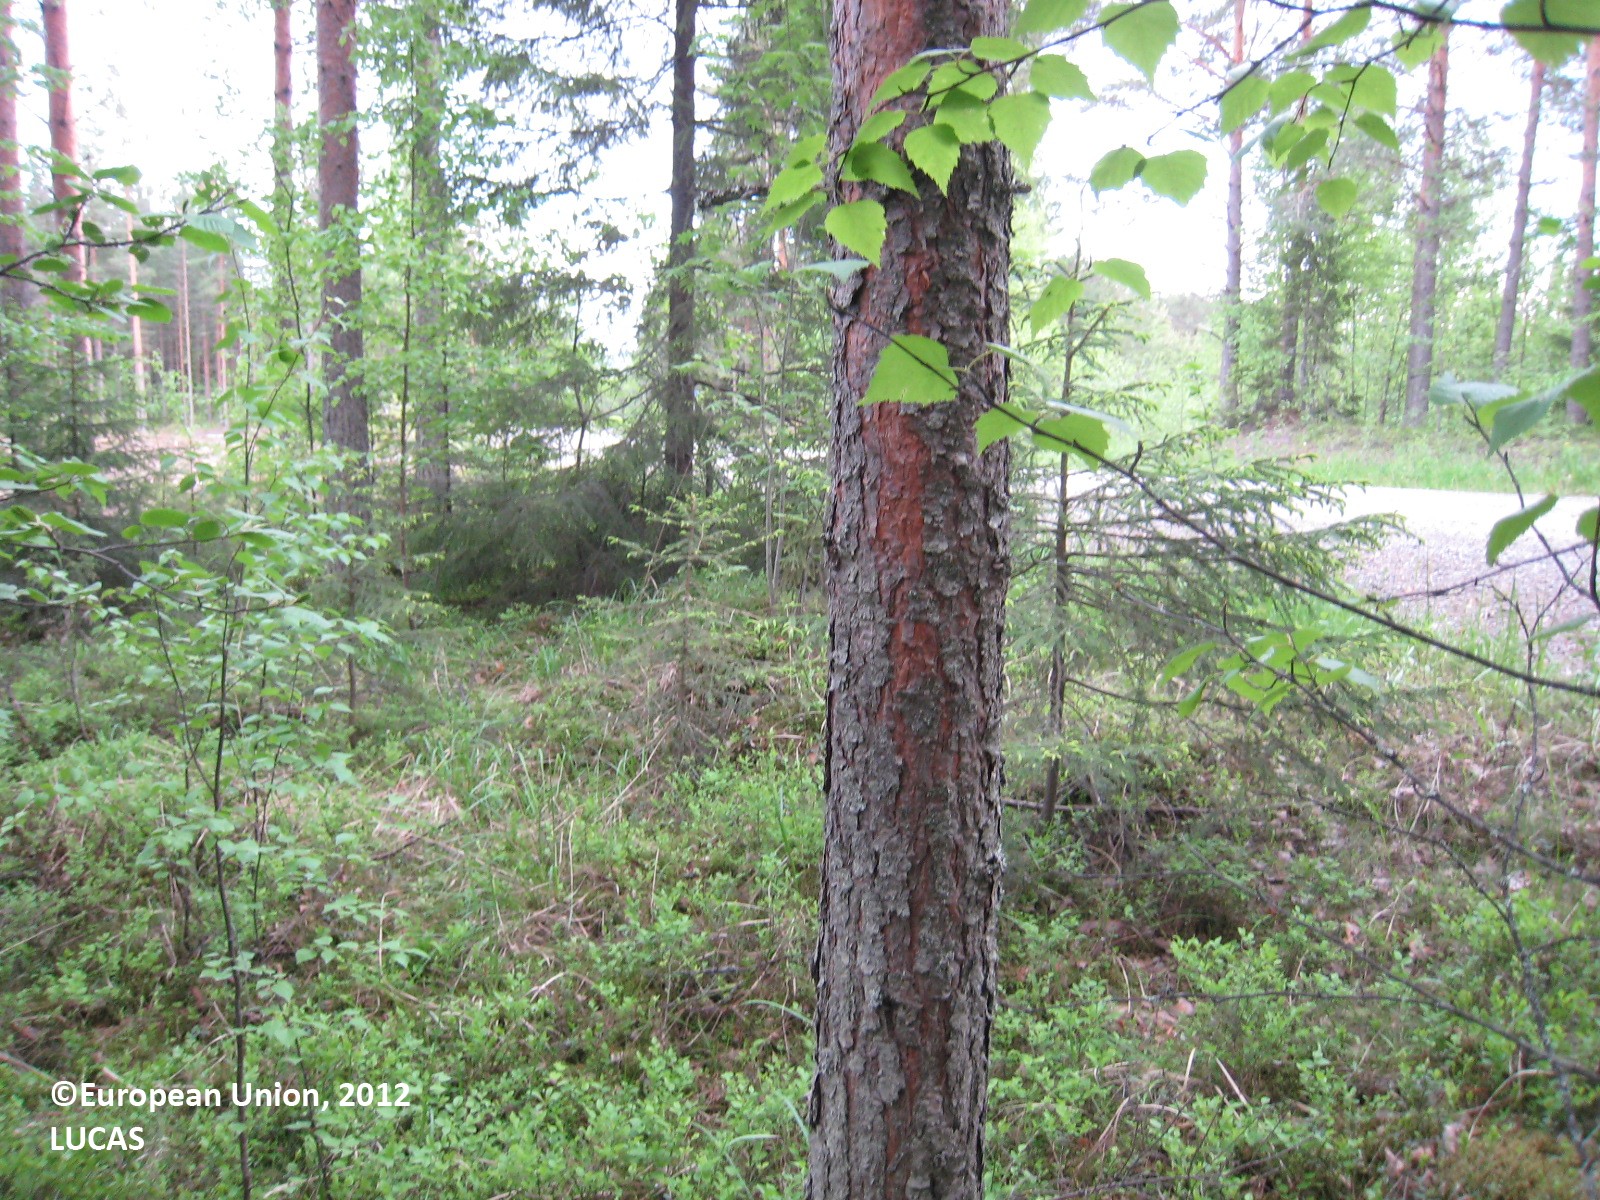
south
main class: Woodland
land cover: Pine dominated mixed woodland
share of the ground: > 75 %
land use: Forestry
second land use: Road transport
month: June
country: FI
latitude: 62.6118
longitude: 26.0438
